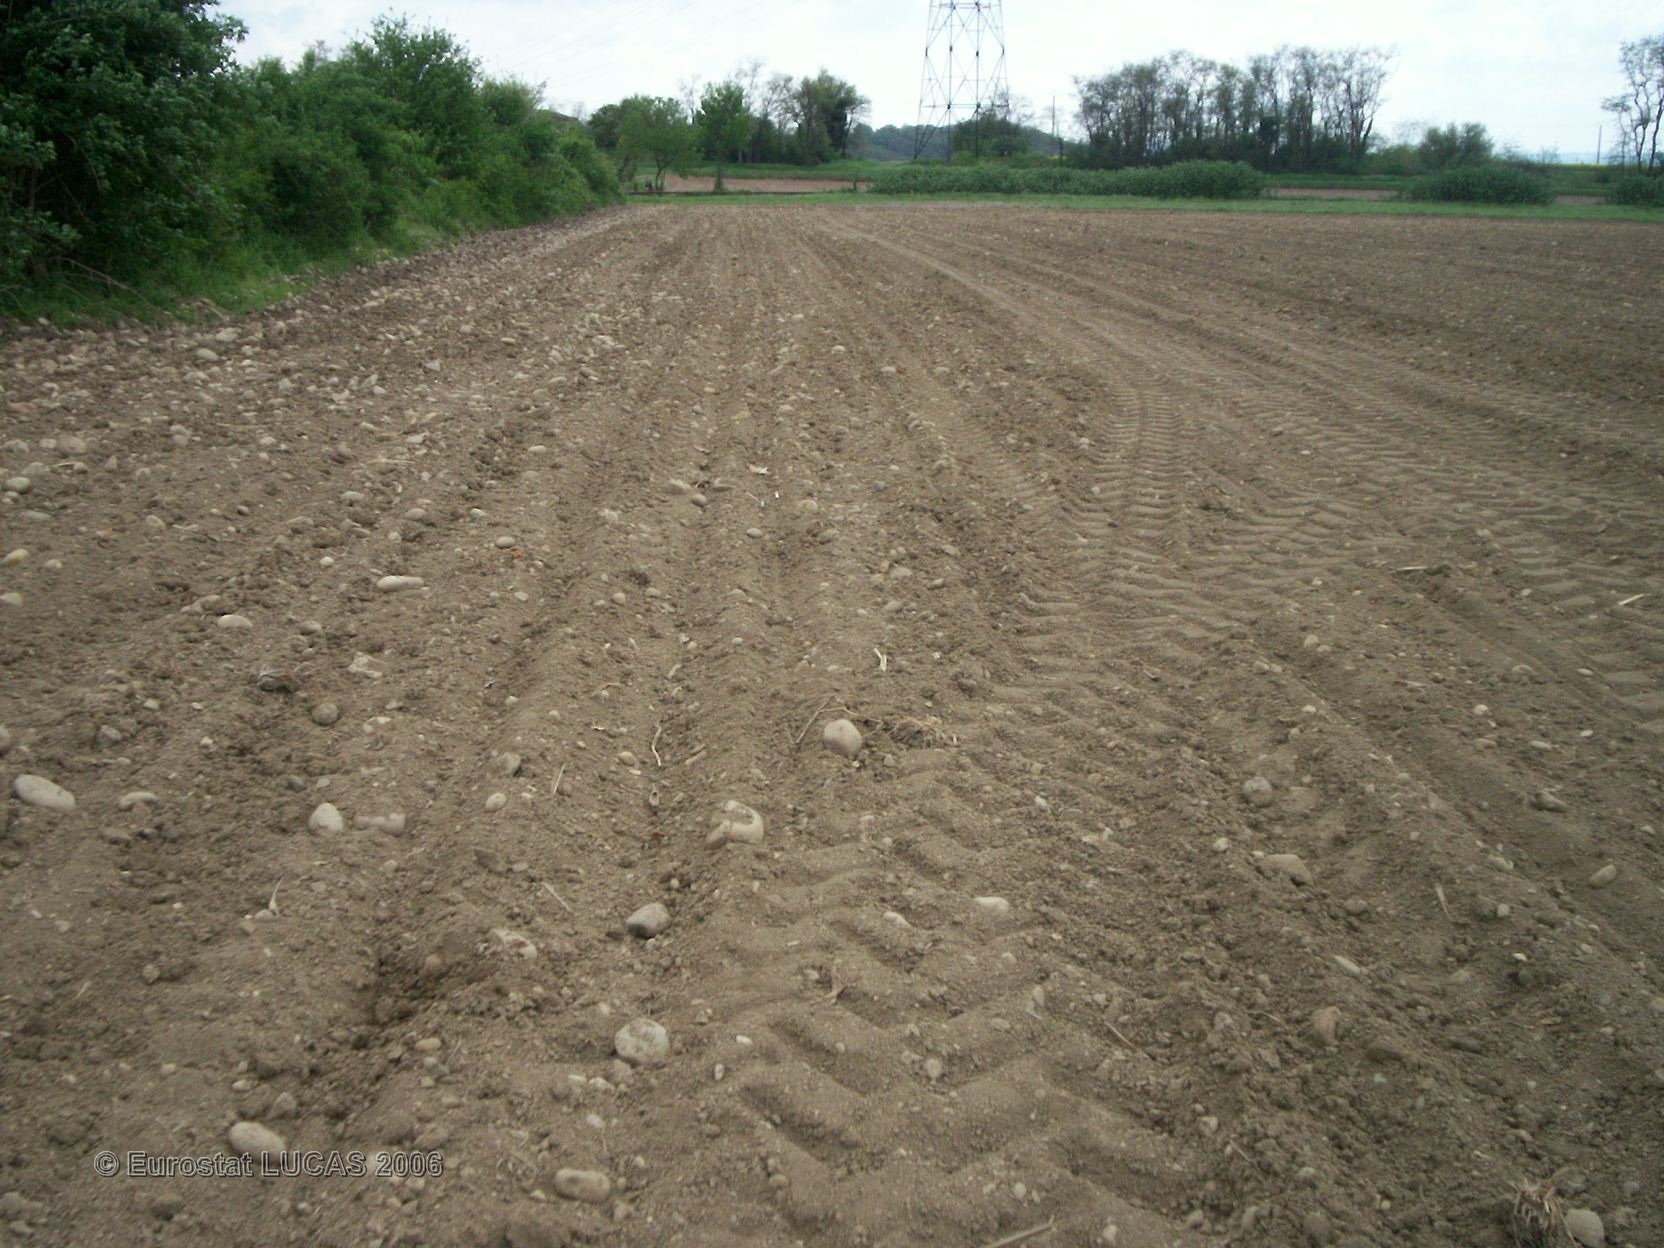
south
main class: Cropland
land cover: Maize
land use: Agriculture (excluding fallow land and kitchen gardens)
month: April
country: FR
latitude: 45.2893
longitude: 4.8664
